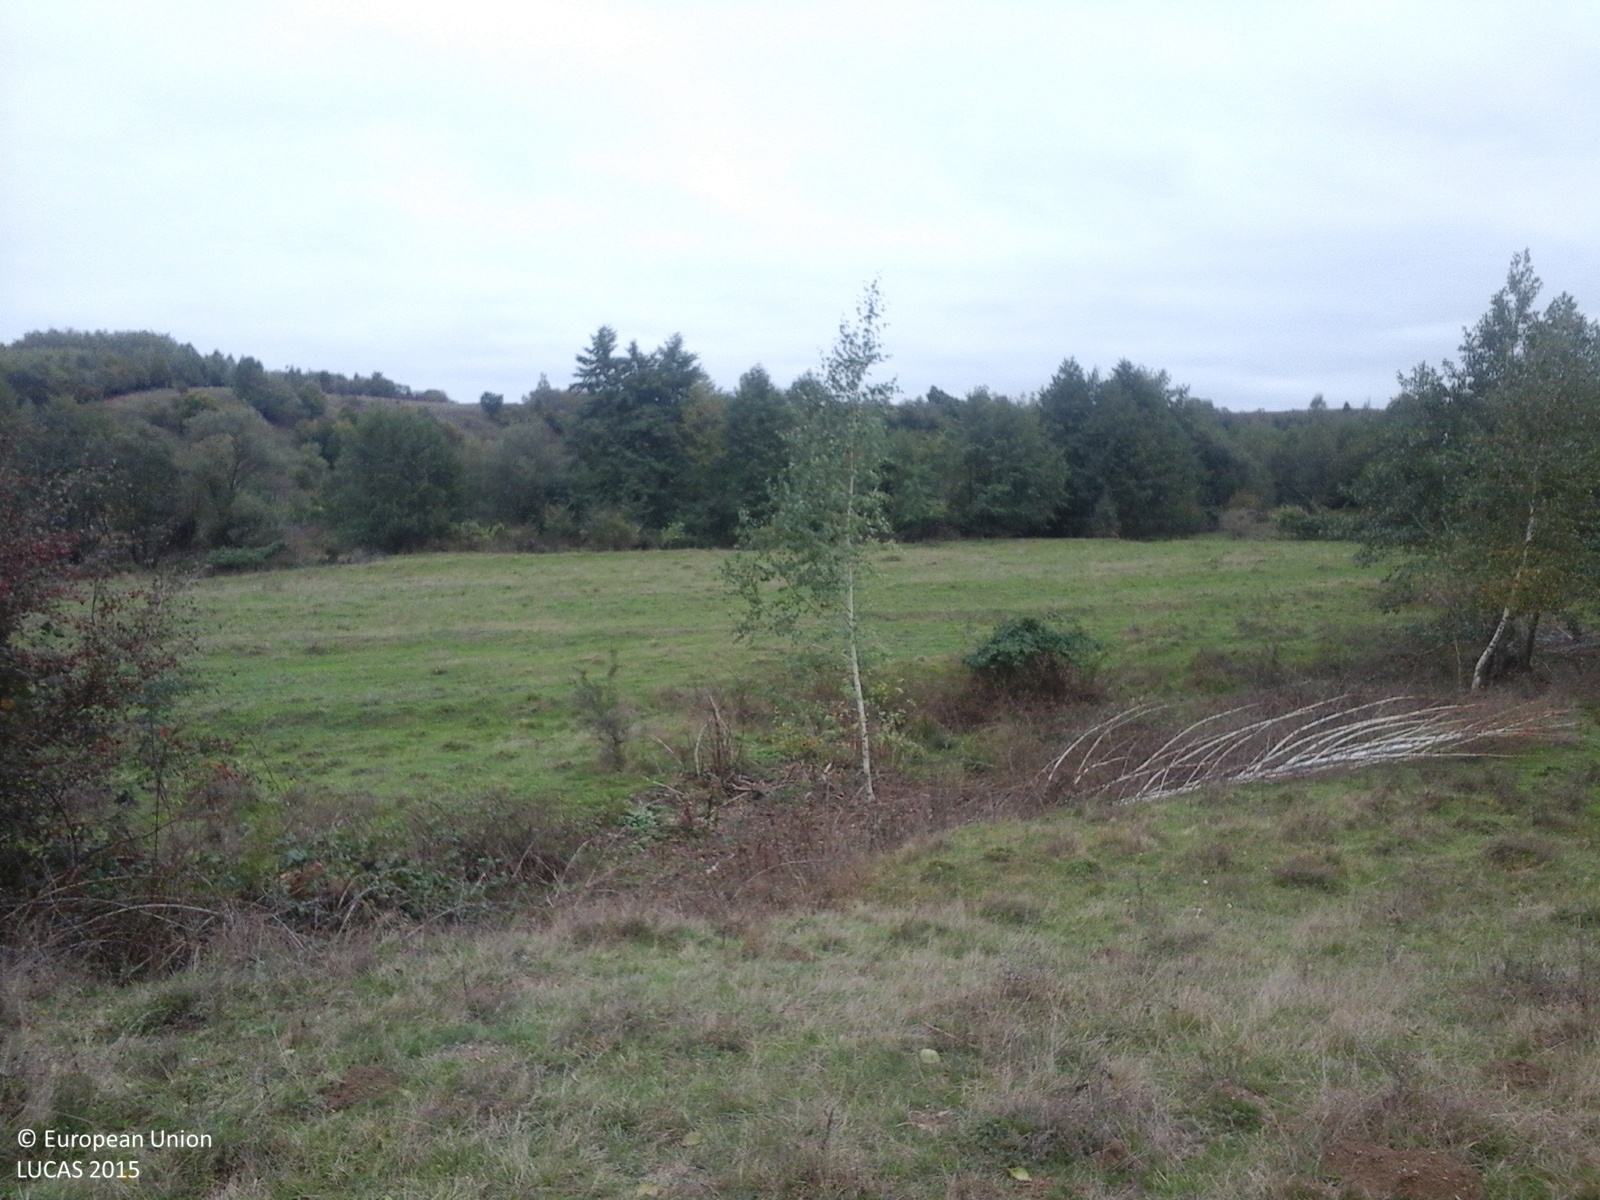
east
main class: Grassland
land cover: Grassland without tree/shrub cover
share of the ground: > 75 %
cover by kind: herbaceous plants 100 %
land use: Agriculture (excluding fallow land and kitchen gardens)
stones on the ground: < 10 %
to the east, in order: Grassland without tree/shrub cover; Ditches and canals; Grassland without tree/shrub cover; Abandoned hedges; Rivers and streams; Abandoned hedges; Grassland with sparse tree/shrub cover; Rivers and streams; Grassland with sparse tree/shrub cover; Maize
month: October
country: RO
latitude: 45.7494
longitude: 24.7011
